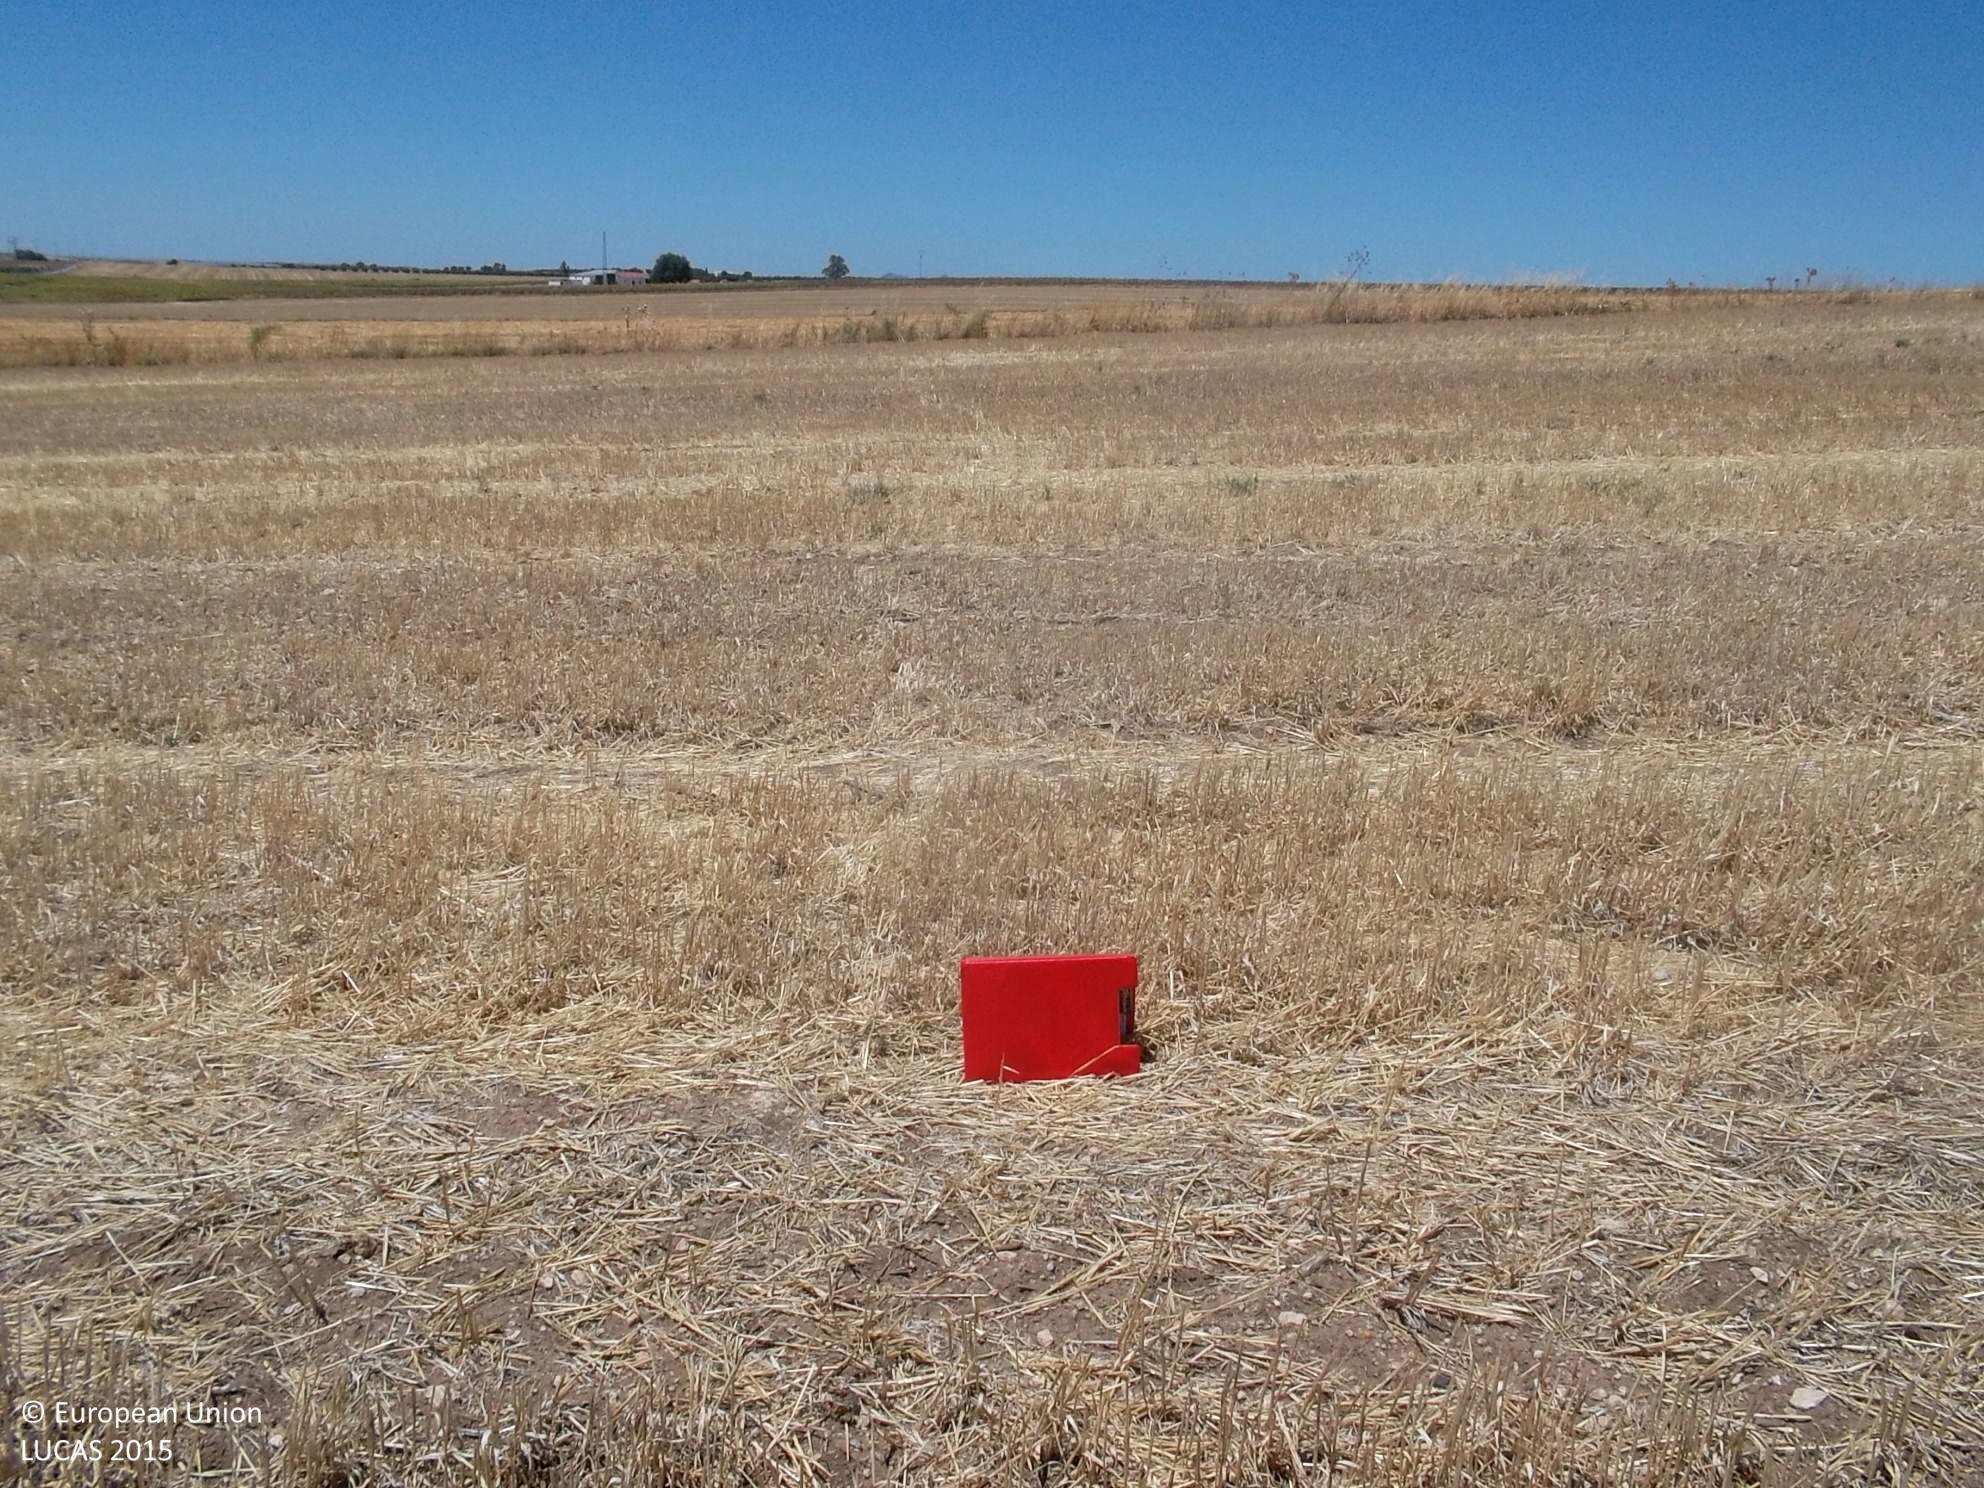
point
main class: Cropland
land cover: Barley
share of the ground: < 10 %
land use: Agriculture (excluding fallow land and kitchen gardens)
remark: Harvested field
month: July
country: ES
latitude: 38.3390
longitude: -5.7684
